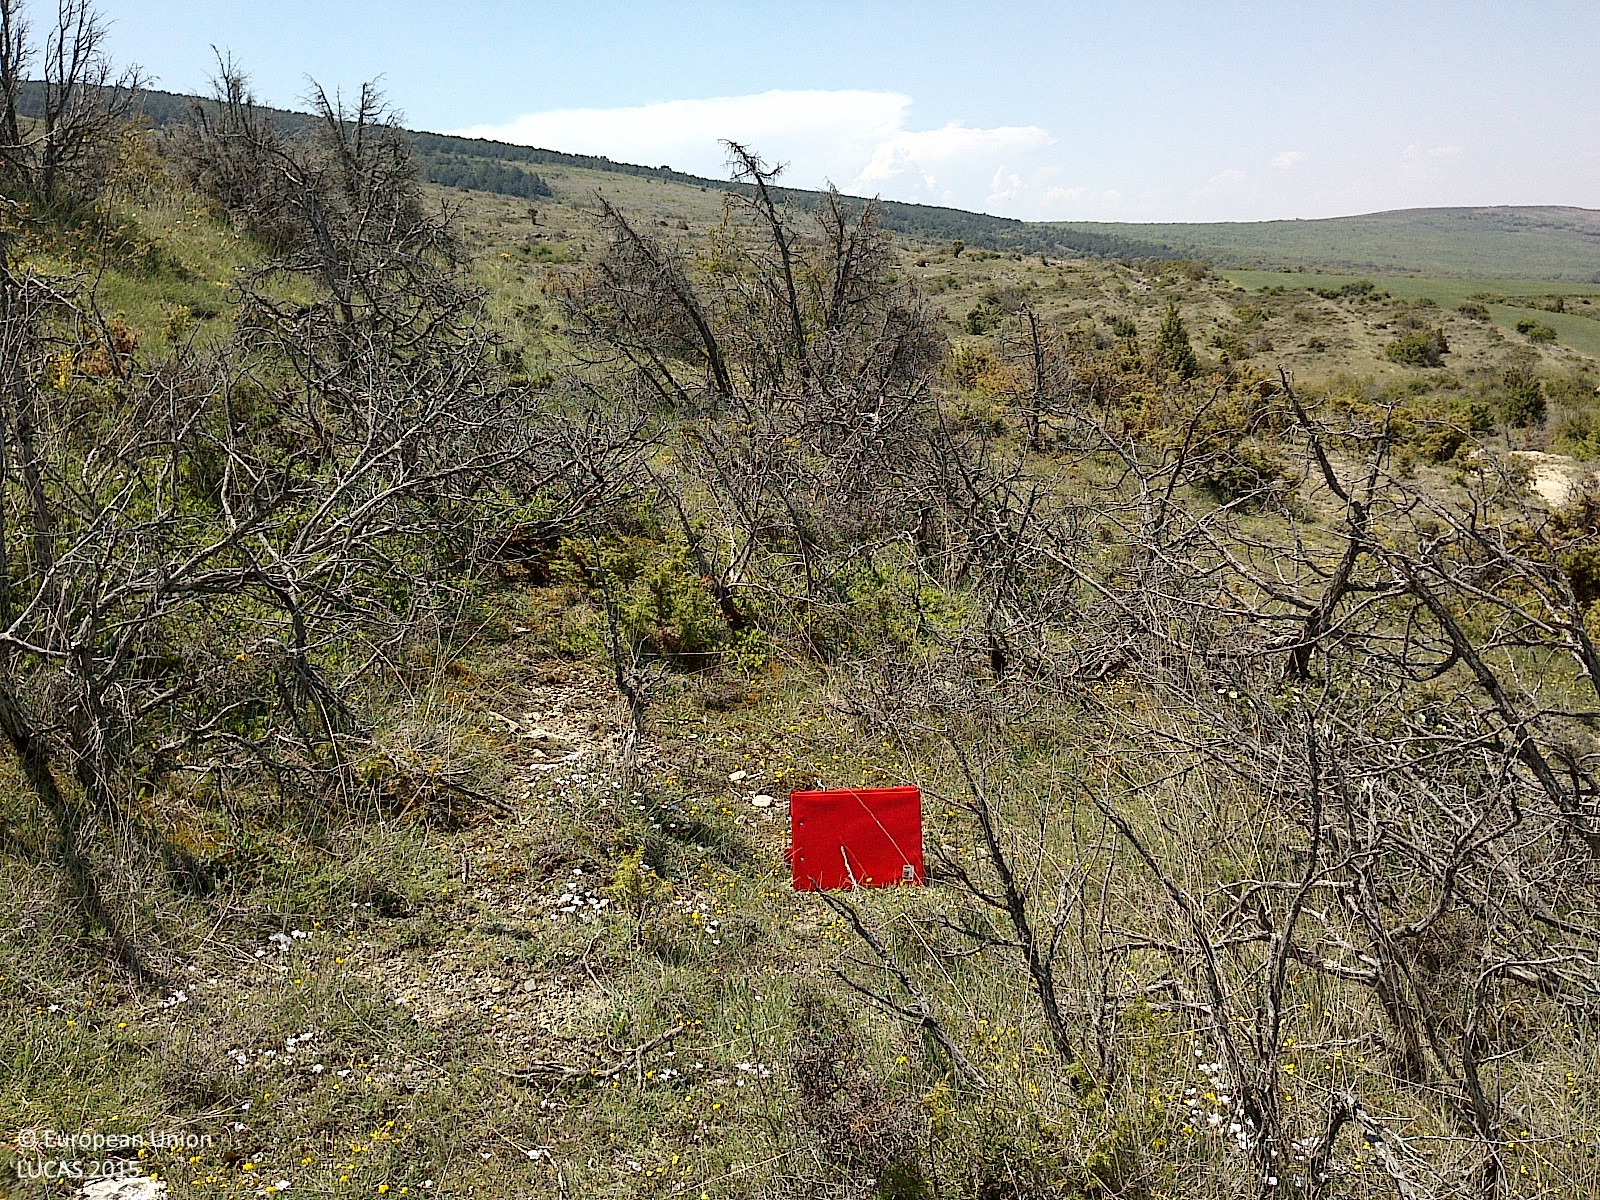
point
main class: Shrubland
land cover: Shrubland with sparse tree cover
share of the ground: 50 - 75 %
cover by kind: shrubs 55 %, herbaceous plants 20 %, consolidated bare surface 20 %, coniferous forest trees 5 %
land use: Semi-natural and natural areas not in use
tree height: < 5 m
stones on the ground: < 10 %
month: May
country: ES
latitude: 41.8512
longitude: -2.2620
